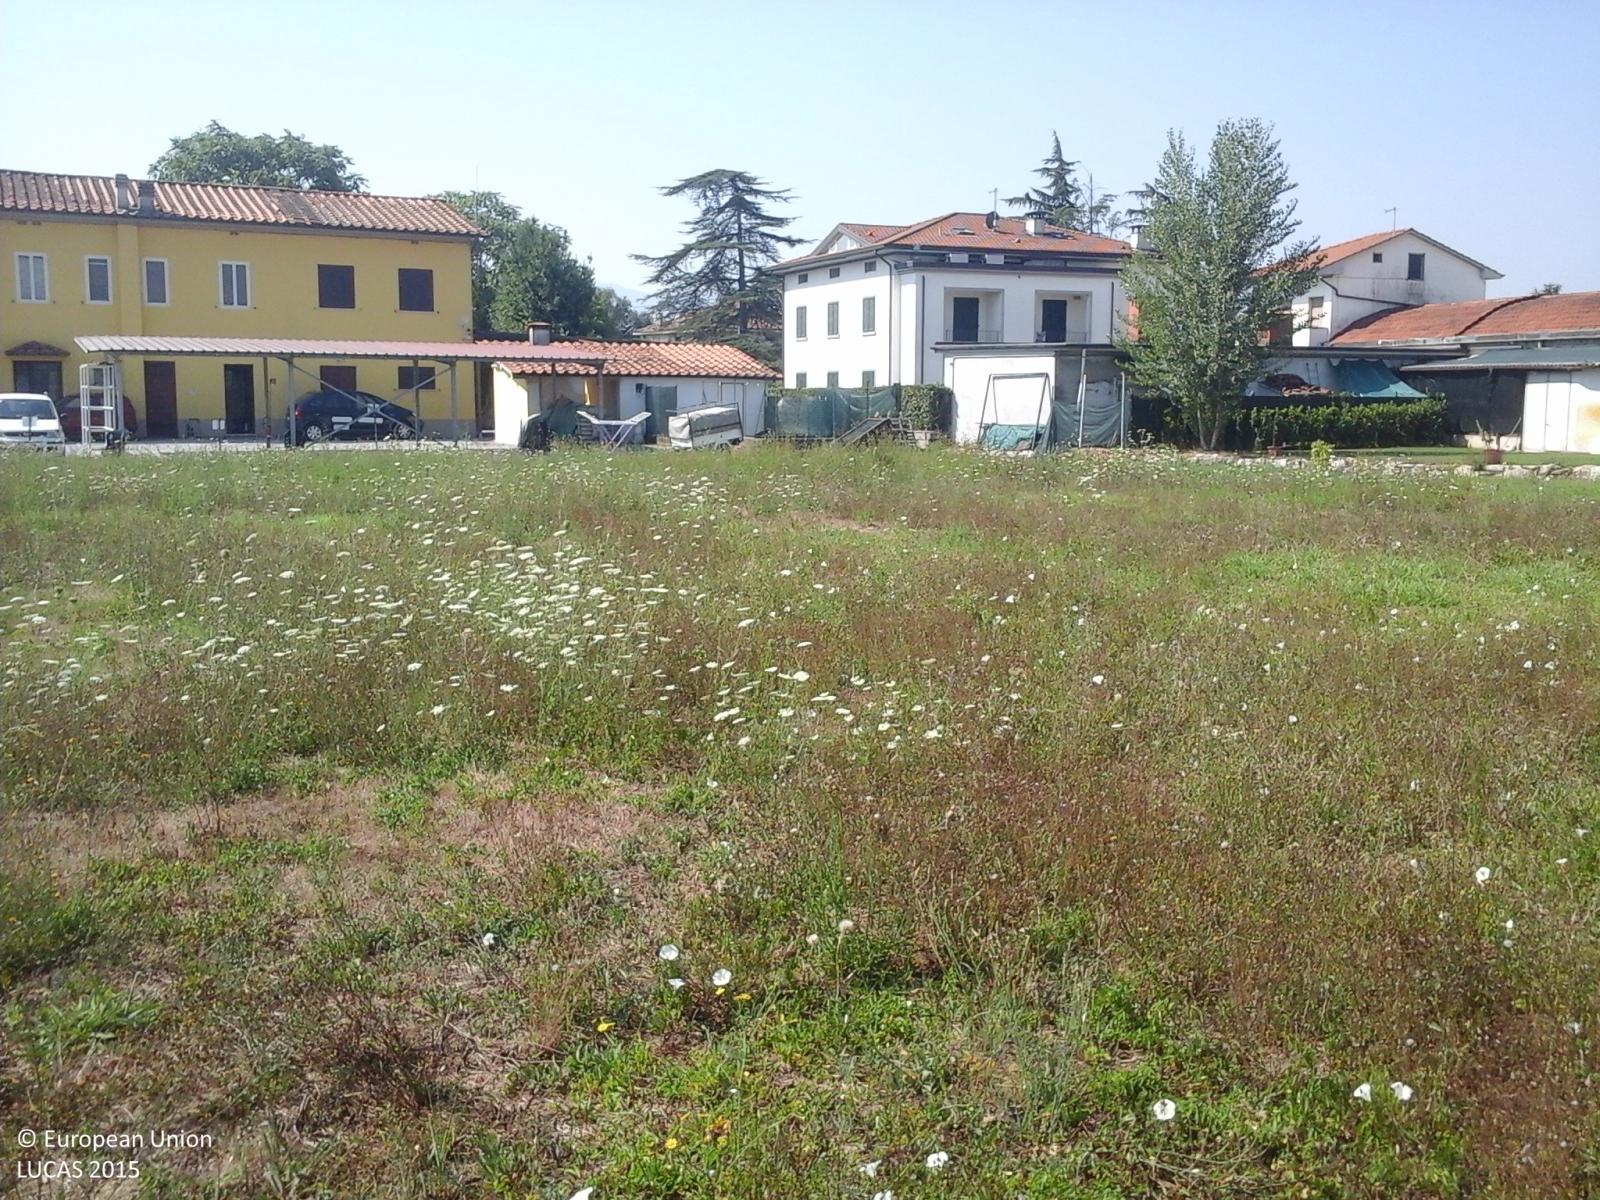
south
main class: Grassland
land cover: Spontaneously vegetated surfaces
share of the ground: > 75 %
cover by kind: herbaceous plants 100 %
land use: Agriculture (excluding fallow land and kitchen gardens)
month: August
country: IT
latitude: 43.8617
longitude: 10.6081
